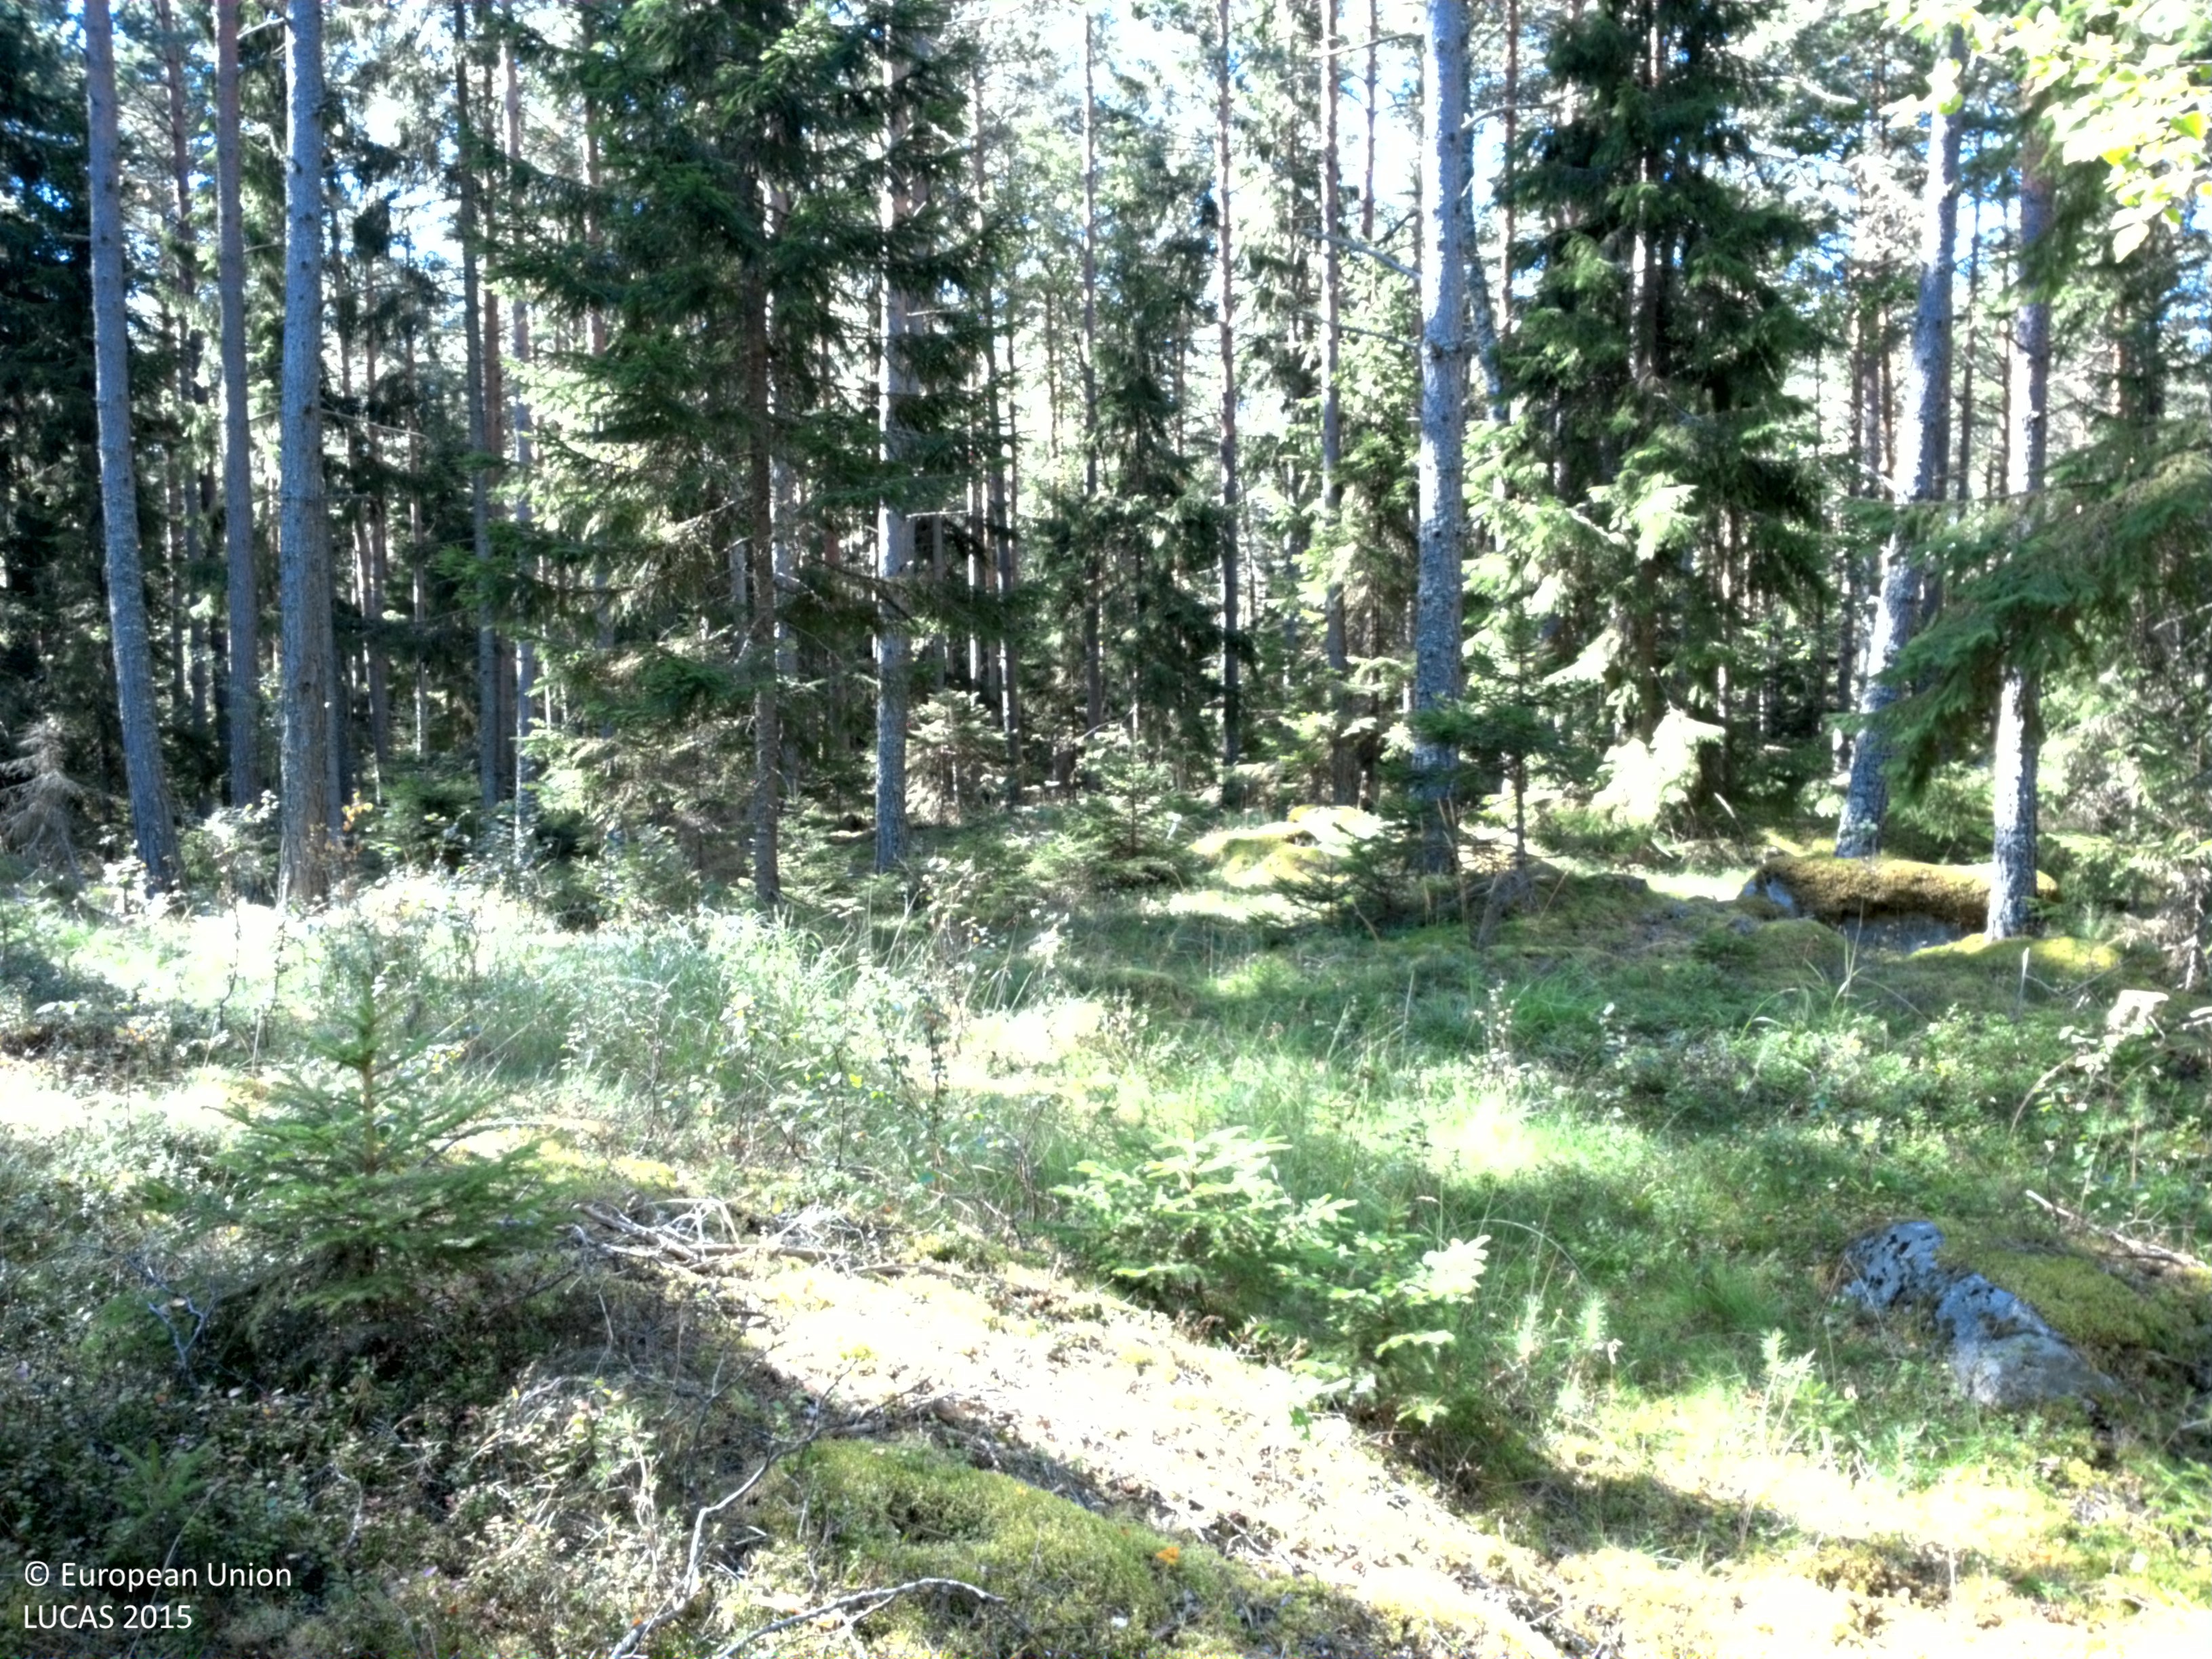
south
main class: Woodland
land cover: Pine dominated coniferous woodland
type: boreal forest
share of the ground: 50 - 75 %
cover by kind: coniferous forest trees 60 %, lichens and mosses 35 %, broadleaved forest trees 5 %
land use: Forestry
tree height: > 5 m
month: August
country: SE
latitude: 59.7549
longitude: 17.6662
